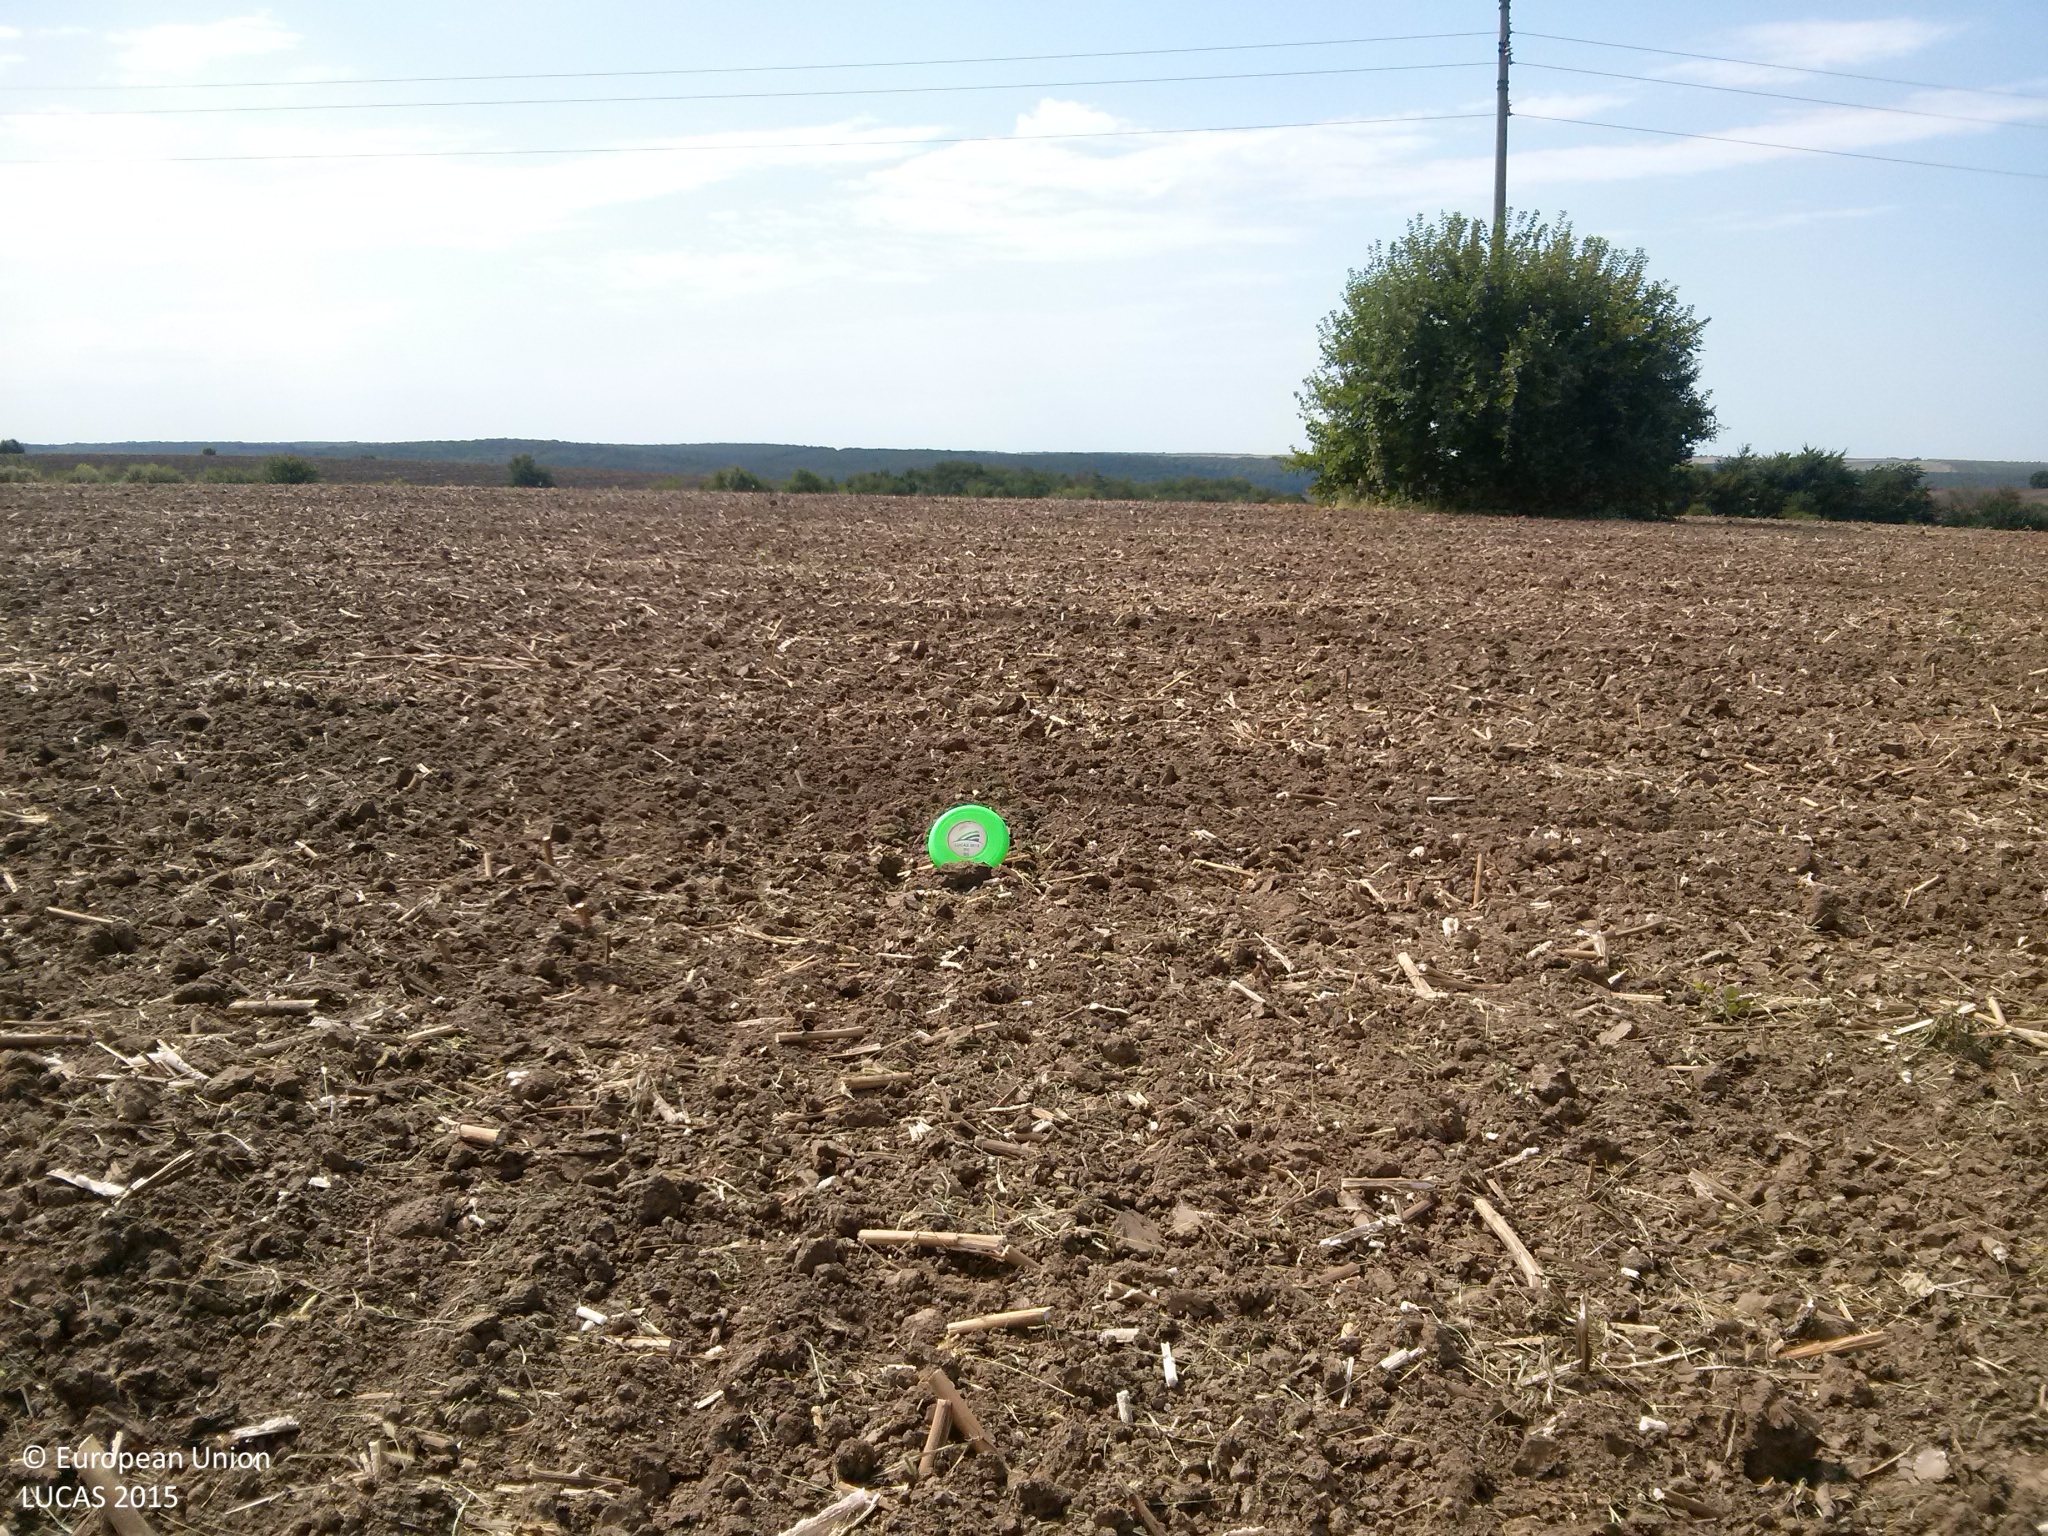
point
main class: Cropland
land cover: Sunflower
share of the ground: < 10 %
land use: Agriculture (excluding fallow land and kitchen gardens)
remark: Harvested field
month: September
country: BG
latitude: 43.8845
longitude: 26.3738
